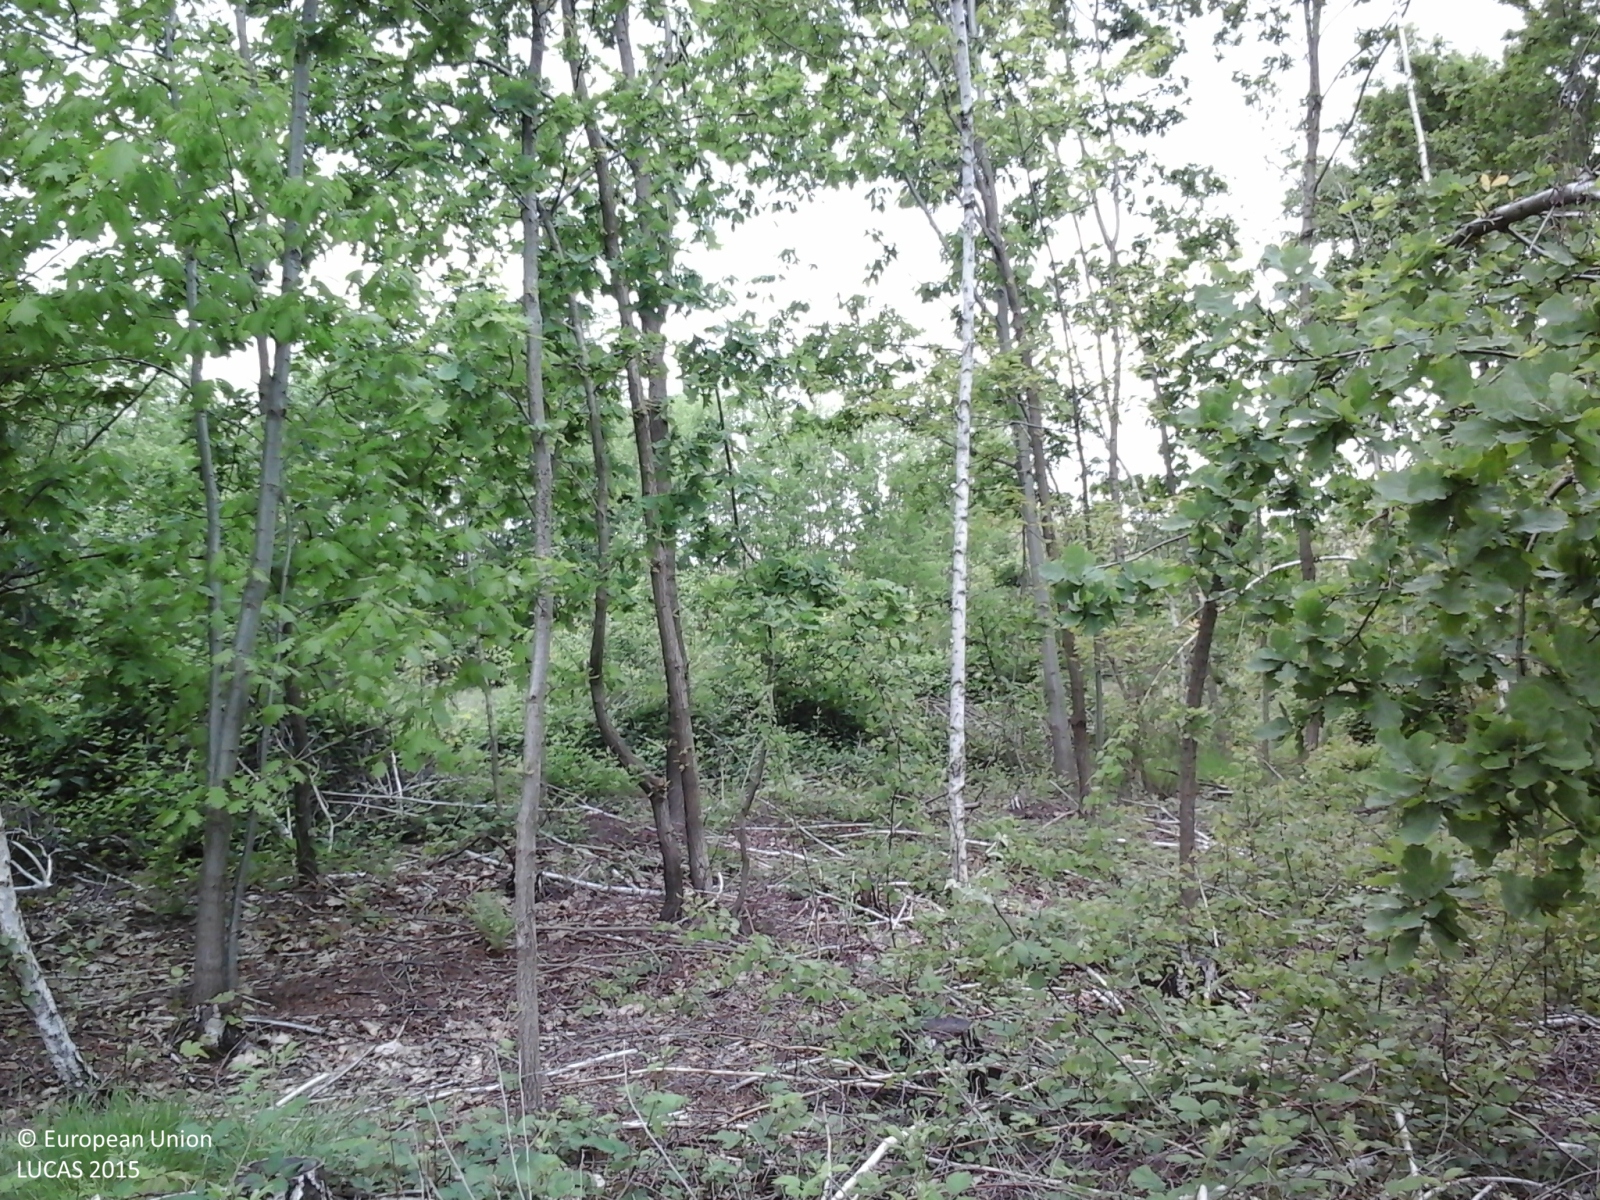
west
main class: Woodland
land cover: Broadleaved woodland
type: thermophilous deciduous forest
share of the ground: > 75 %
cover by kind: broadleaved forest trees 100 %
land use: Forestry
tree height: > 5 m
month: May
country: IT
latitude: 45.5839
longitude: 8.5029
